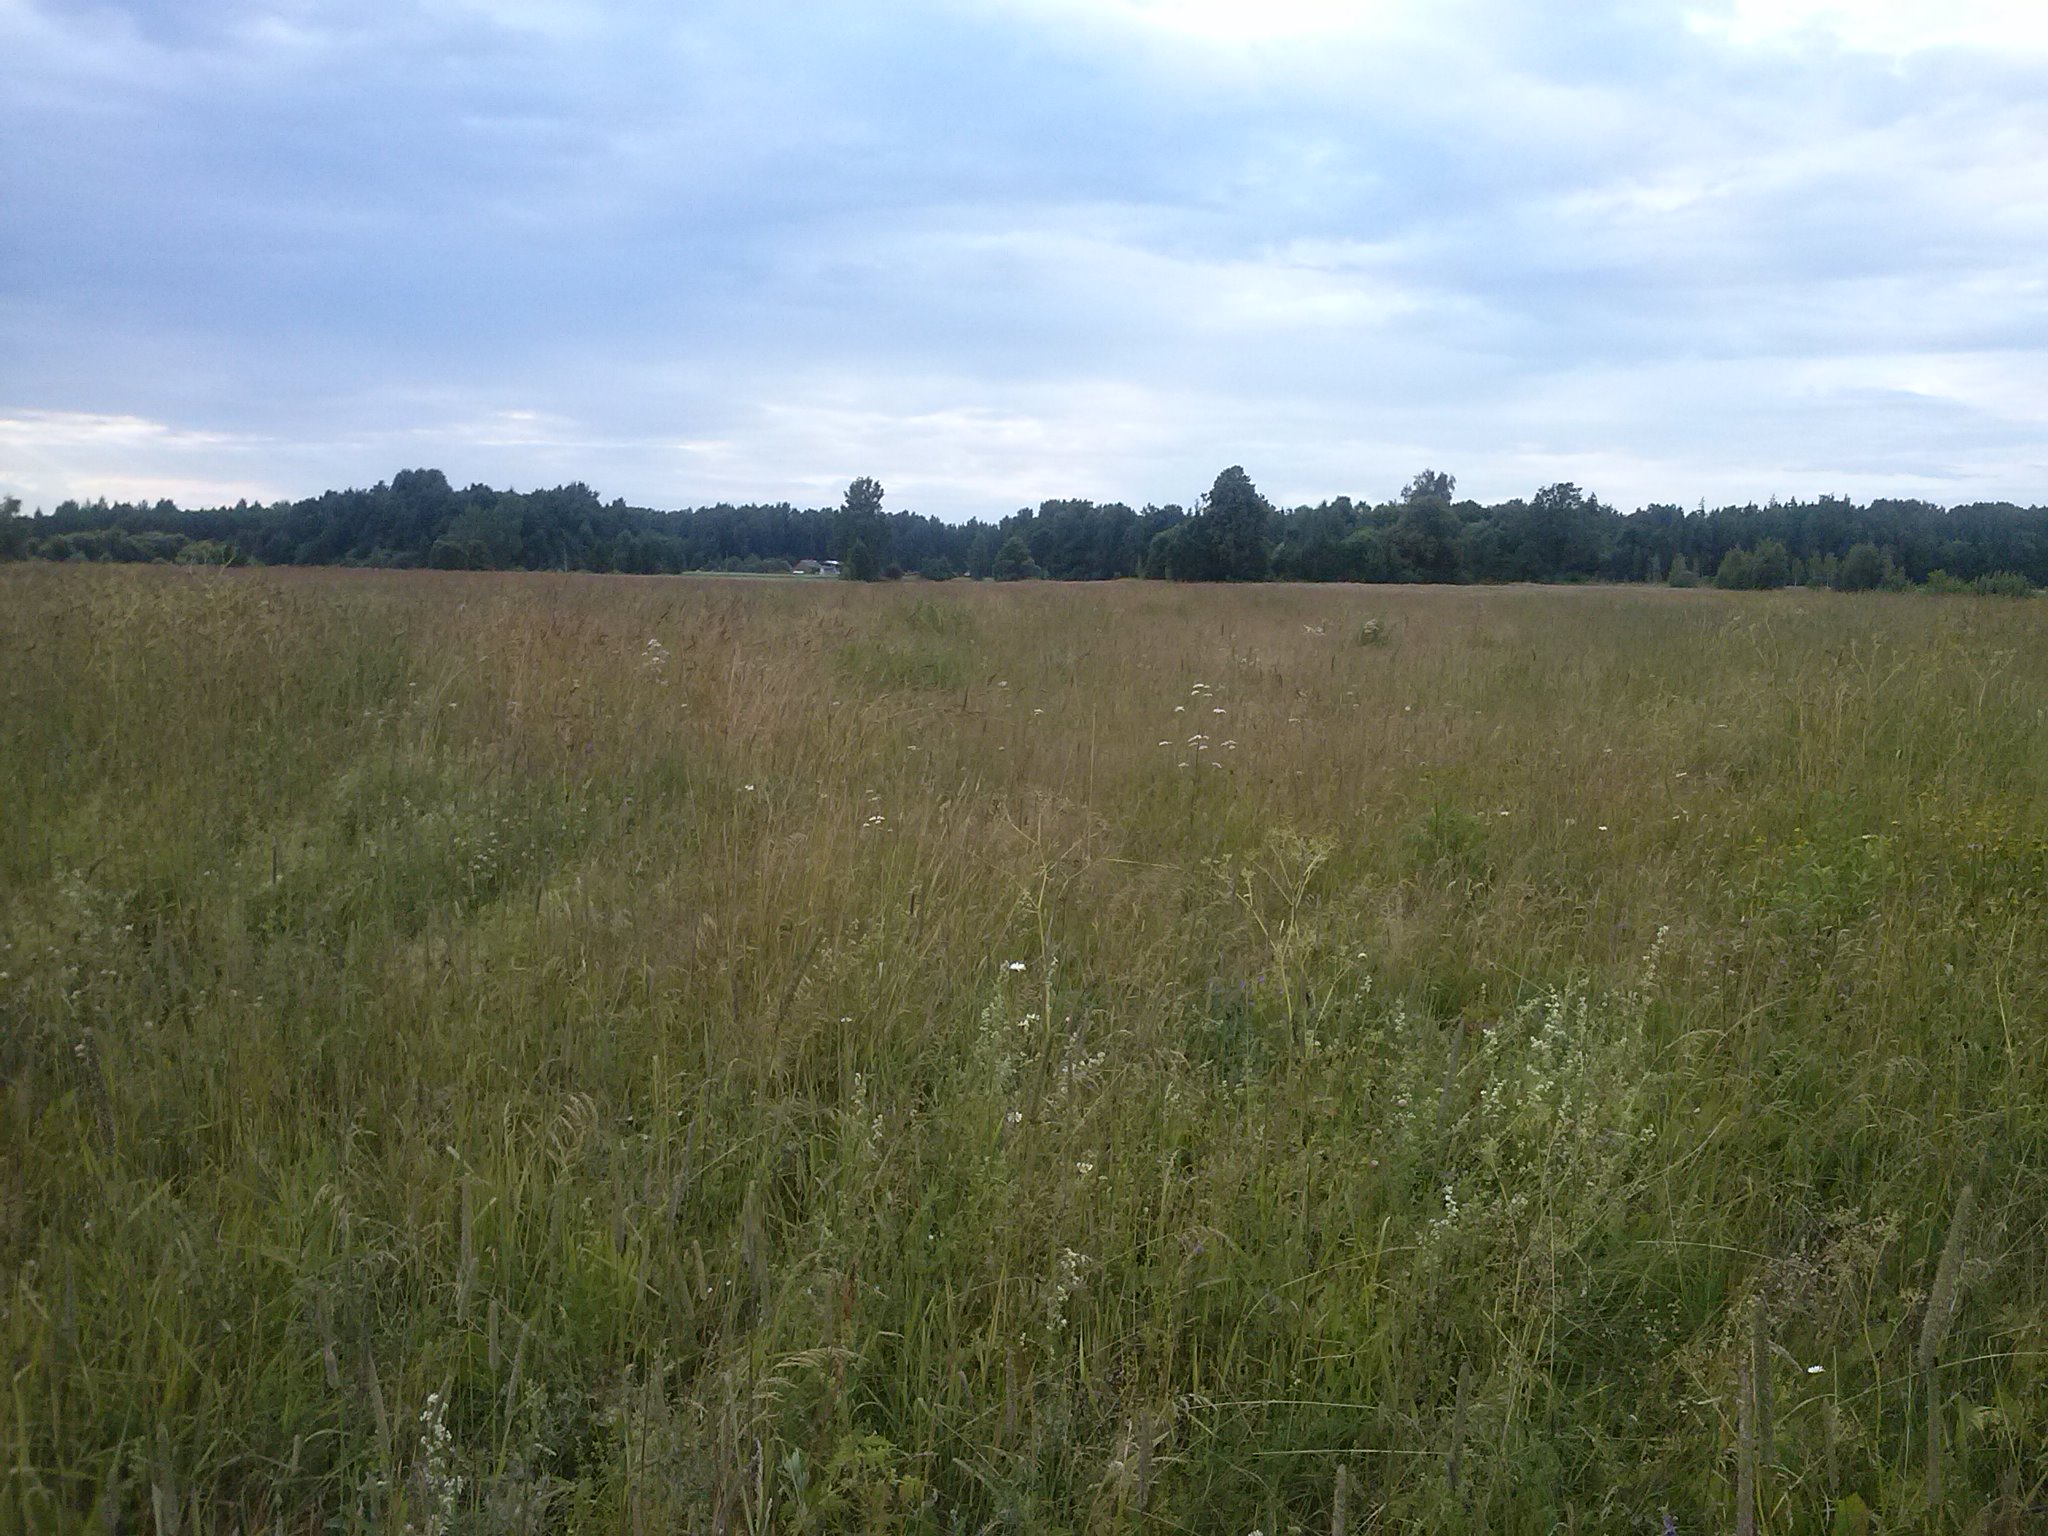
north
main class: Grassland
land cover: Grassland without tree/shrub cover
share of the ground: > 75 %
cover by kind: herbaceous plants 100 %
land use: Agriculture (excluding fallow land and kitchen gardens)
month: July
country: LV
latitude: 56.7606
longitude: 27.7718
